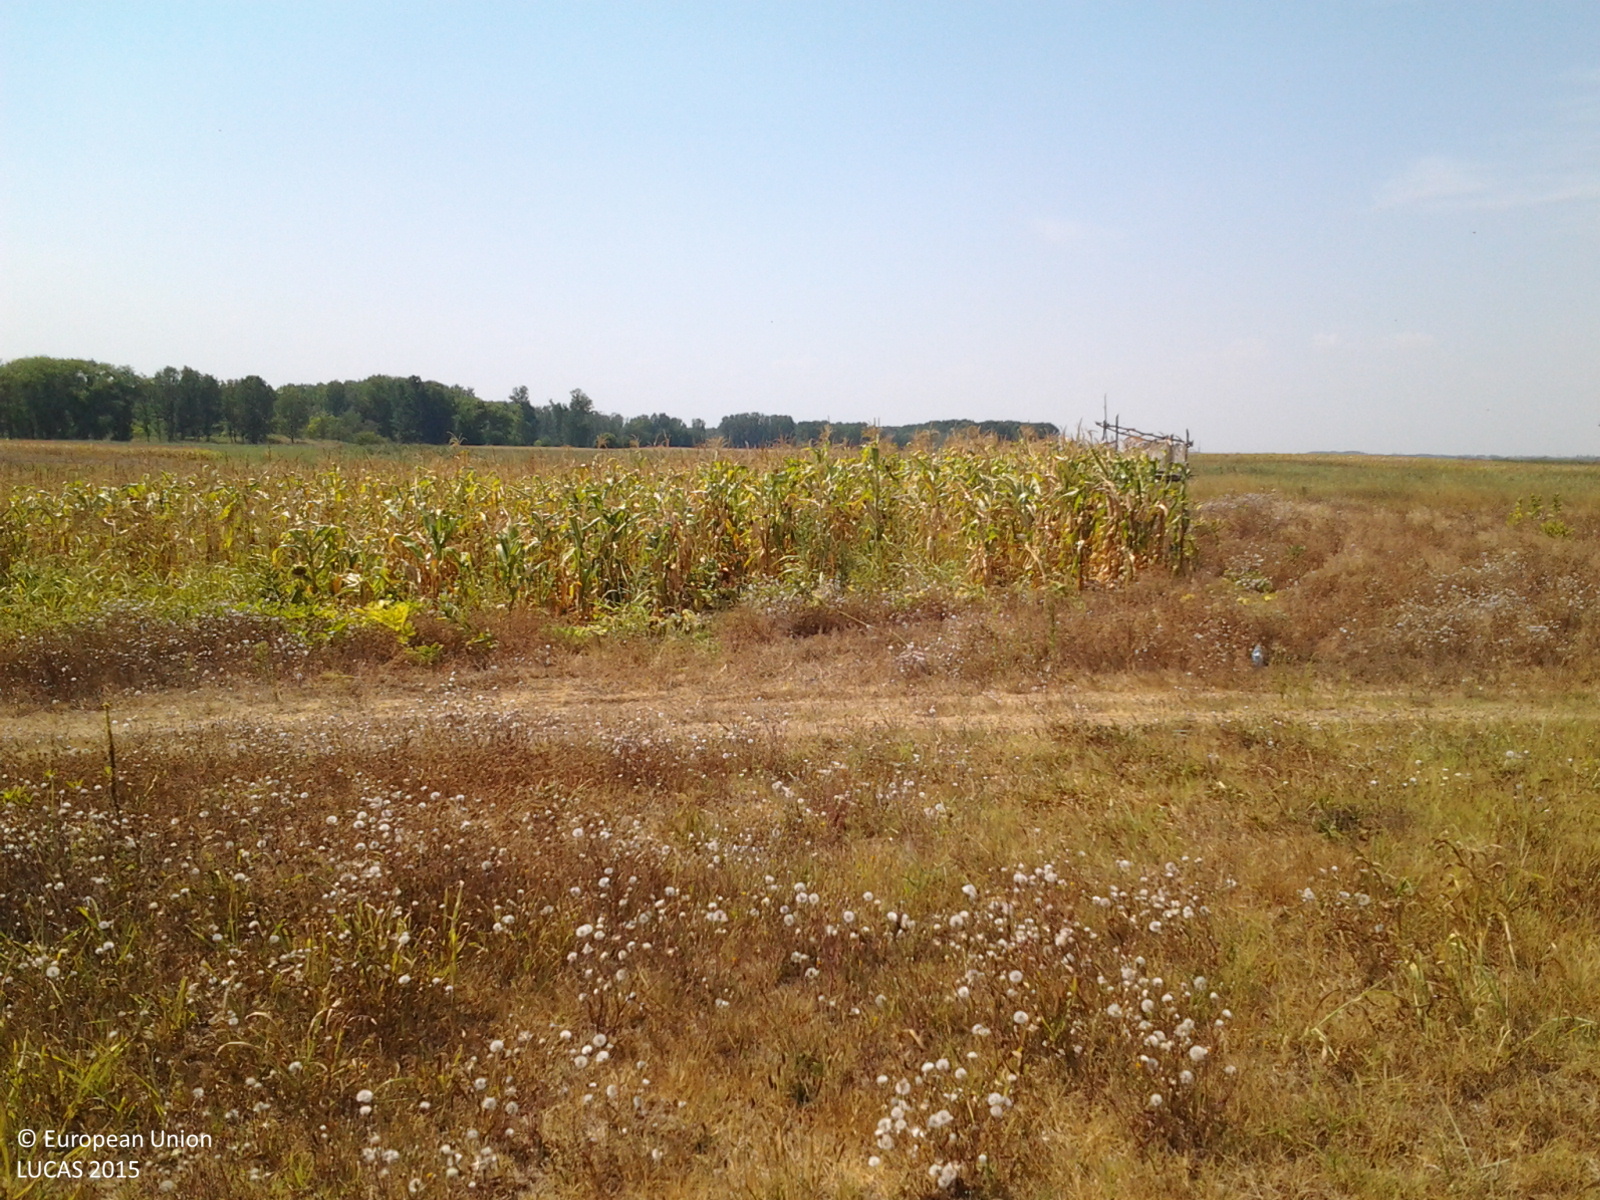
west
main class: Cropland
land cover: Maize
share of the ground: > 75 %
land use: Agriculture (excluding fallow land and kitchen gardens)
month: August
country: RO
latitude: 43.8345
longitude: 23.0366
